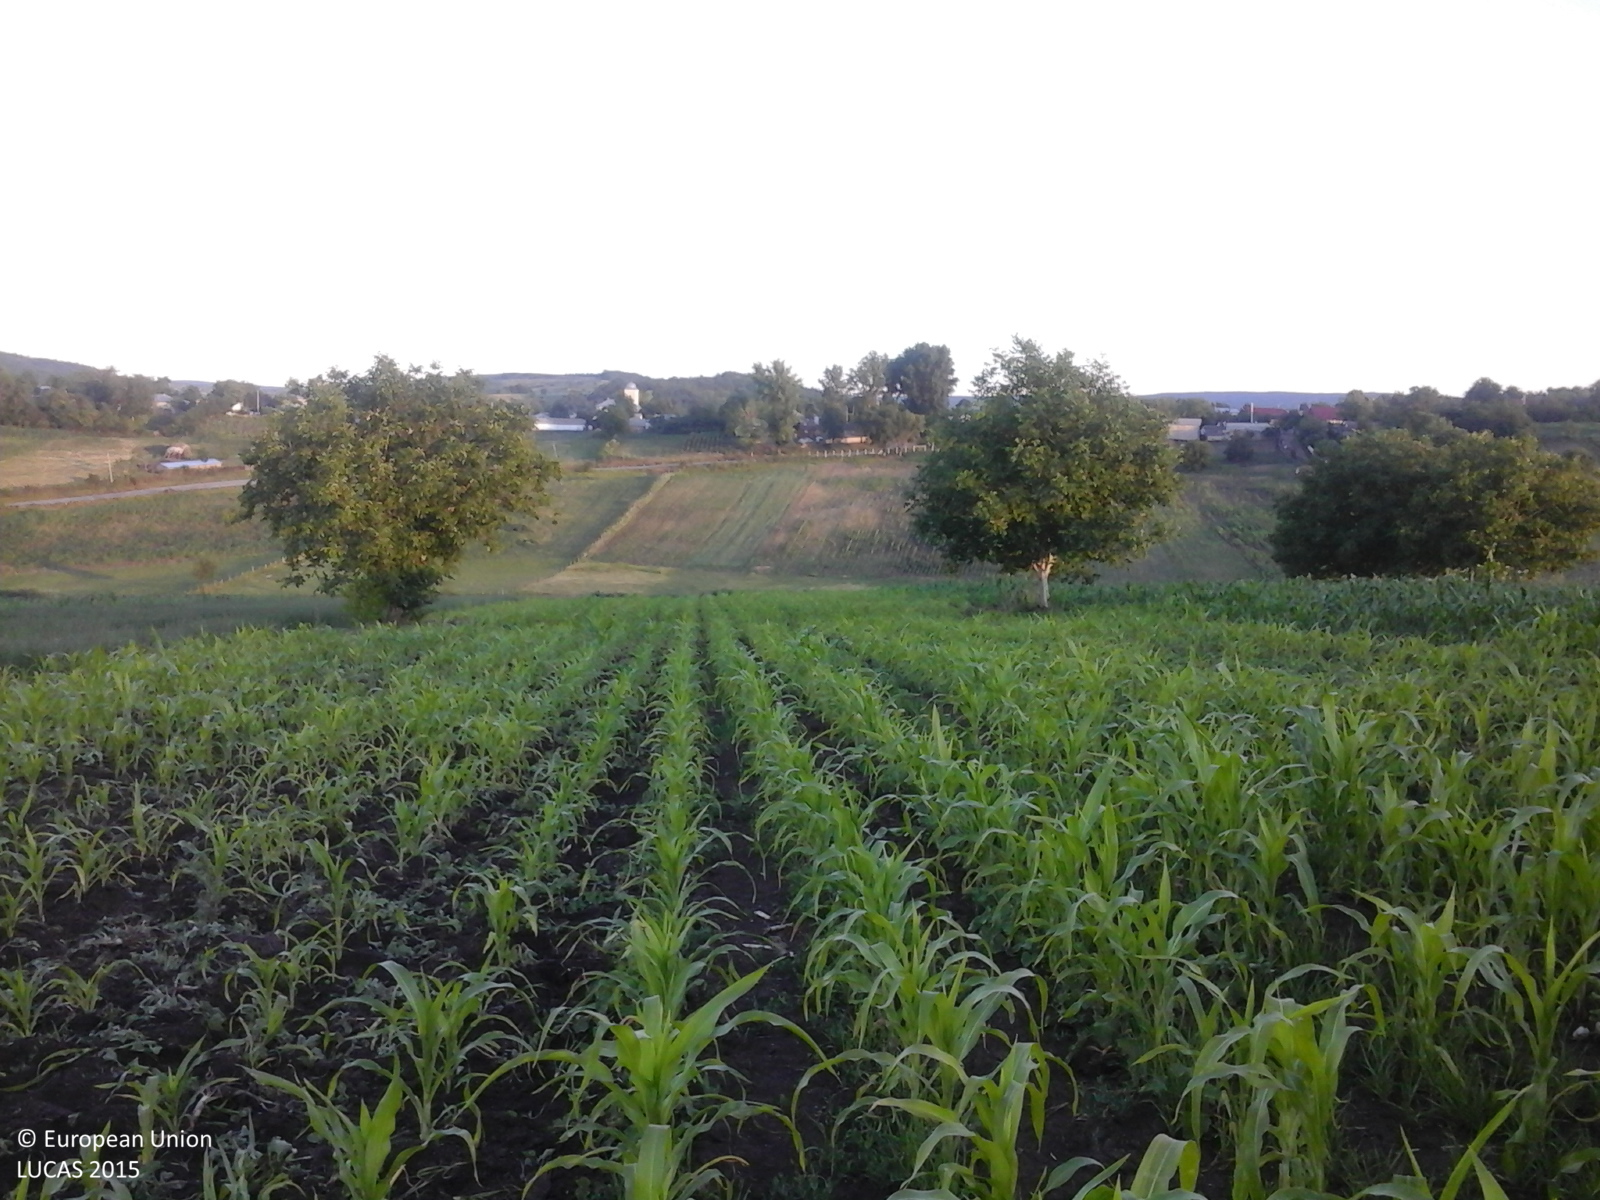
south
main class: Cropland
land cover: Maize
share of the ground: 50 - 75 %
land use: Agriculture (excluding fallow land and kitchen gardens)
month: June
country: RO
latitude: 47.1628
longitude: 27.1346
